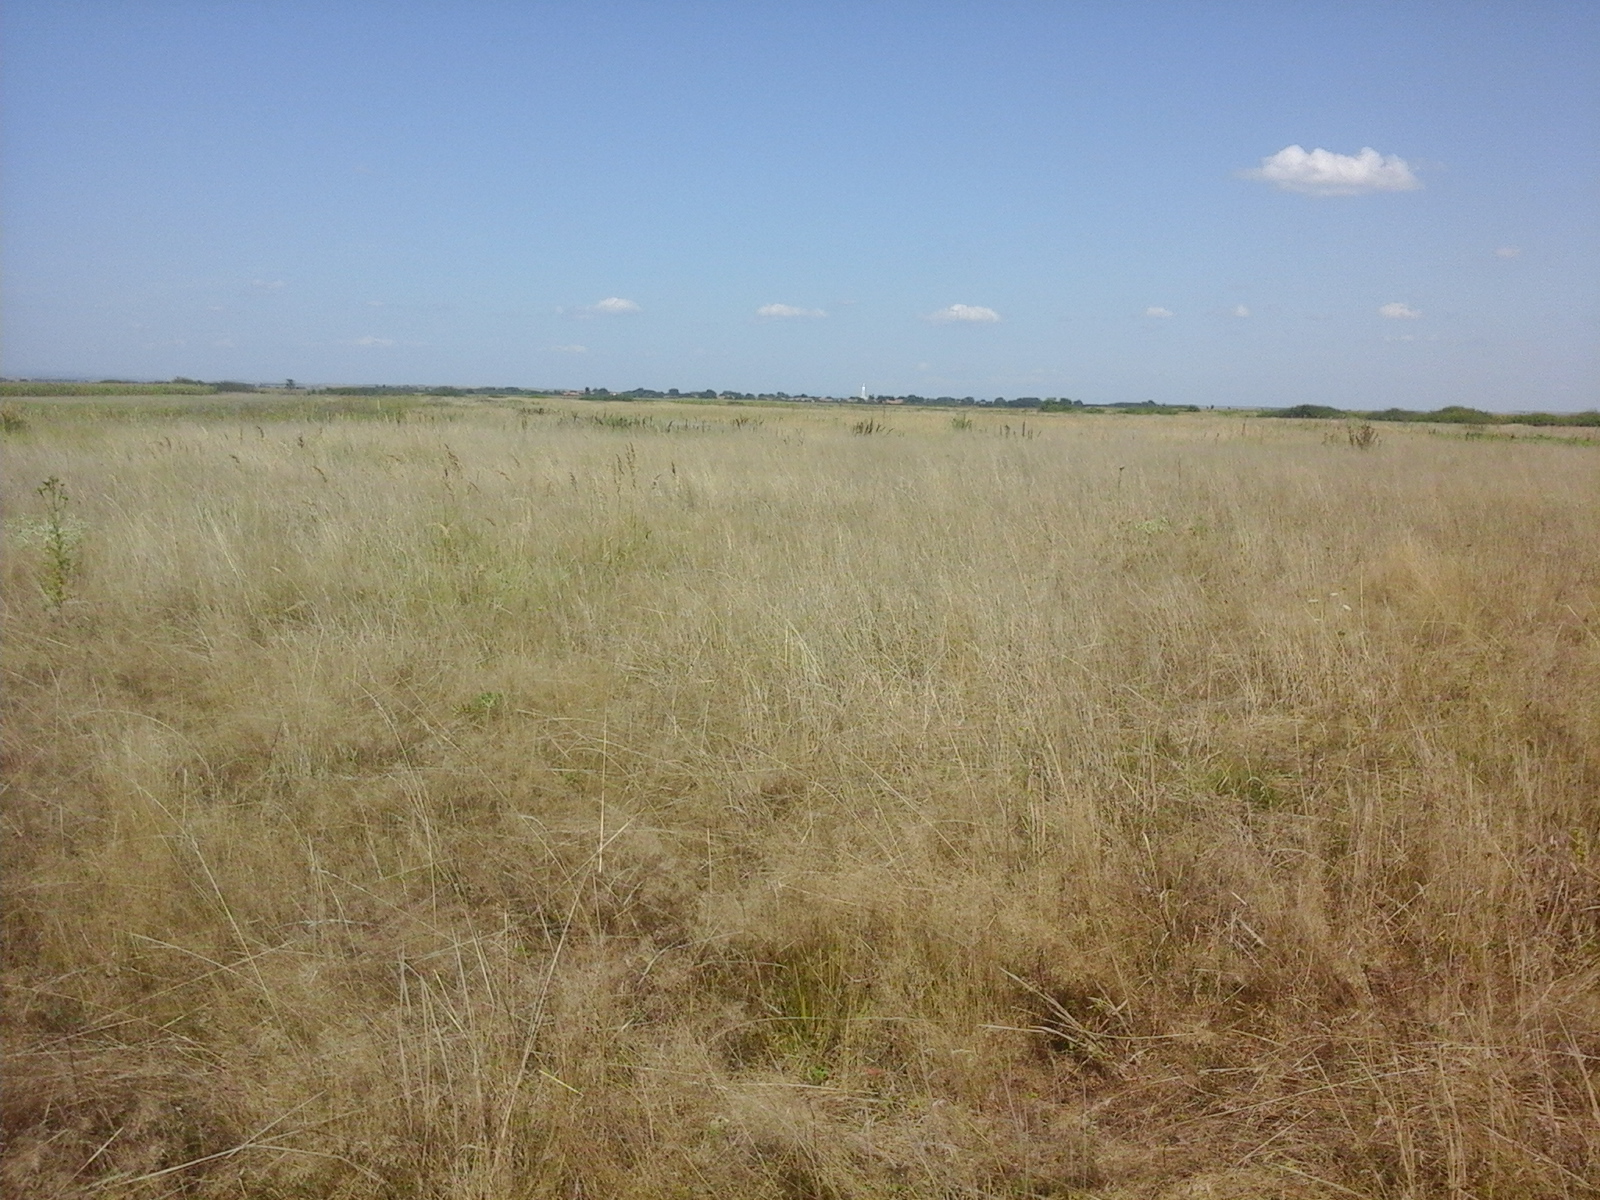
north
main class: Grassland
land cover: Spontaneously vegetated surfaces
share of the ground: > 75 %
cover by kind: herbaceous plants 100 %
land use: Agriculture (excluding fallow land and kitchen gardens)
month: August
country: RO
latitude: 45.6969
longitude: 21.7878
